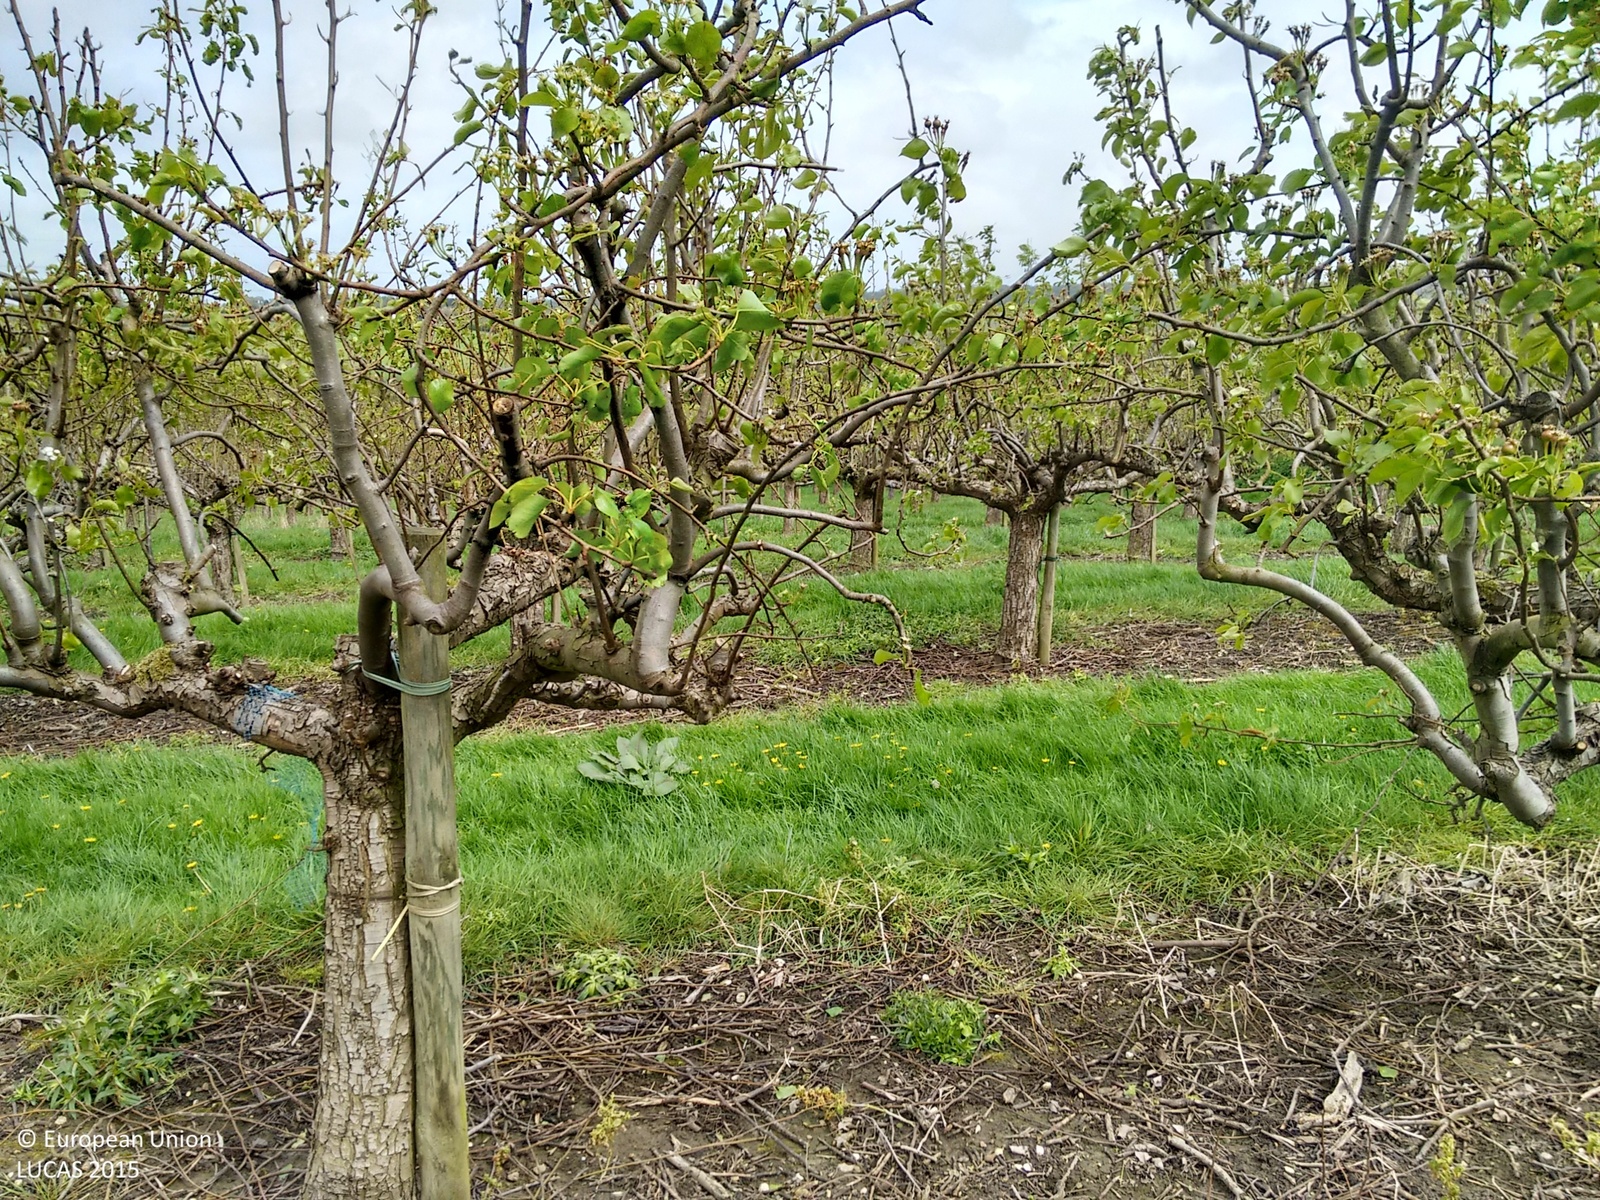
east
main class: Cropland
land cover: Pear fruit
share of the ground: 50 - 75 %
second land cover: Grassland without tree/shrub cover
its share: 50 - 75 %
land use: Agriculture (excluding fallow land and kitchen gardens)
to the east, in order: Pear fruit; Grassland without tree/shrub cover; Tracks; Managed hedges; Grassland without tree/shrub cover; Tracks; Grassland without tree/shrub cover; Managed hedges; Shruby margins; Electric lines; Grassland without tree/shrub cover; Tracks; Grassland without tree/shrub cover; Pear fruit
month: May
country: GB
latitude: 51.2726
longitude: 0.2946
